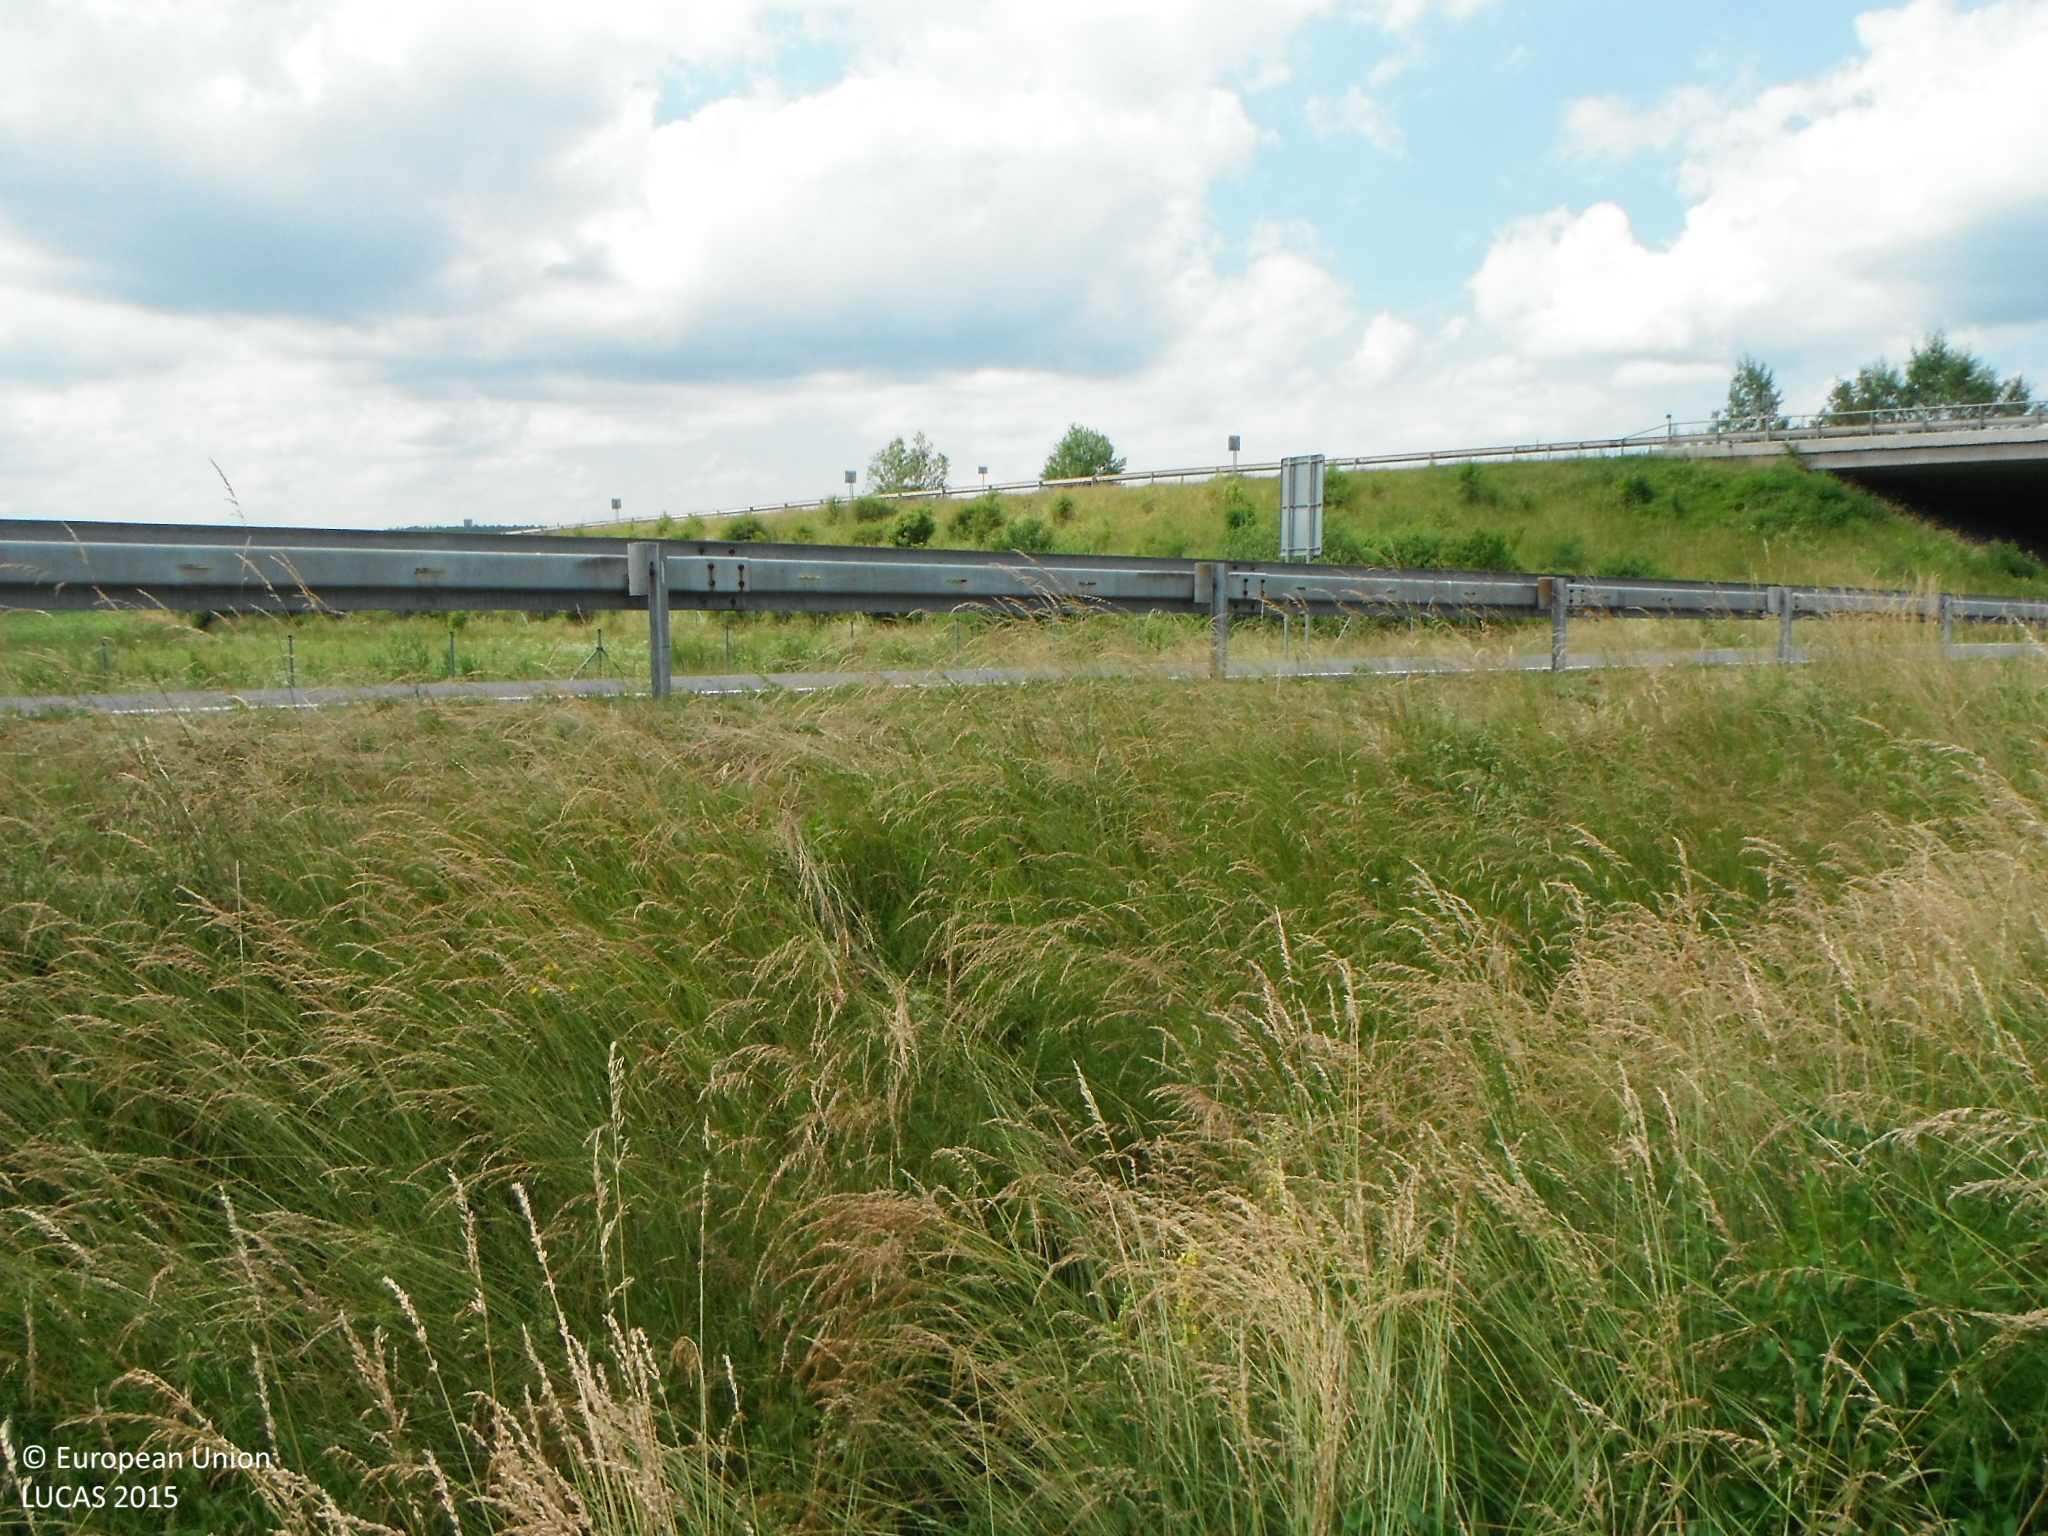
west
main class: Grassland
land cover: Grassland without tree/shrub cover
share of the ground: > 75 %
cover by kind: herbaceous plants 100 %
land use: Protection infrastructures
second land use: Road transport
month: June
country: SK
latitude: 48.6052
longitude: 19.1218
